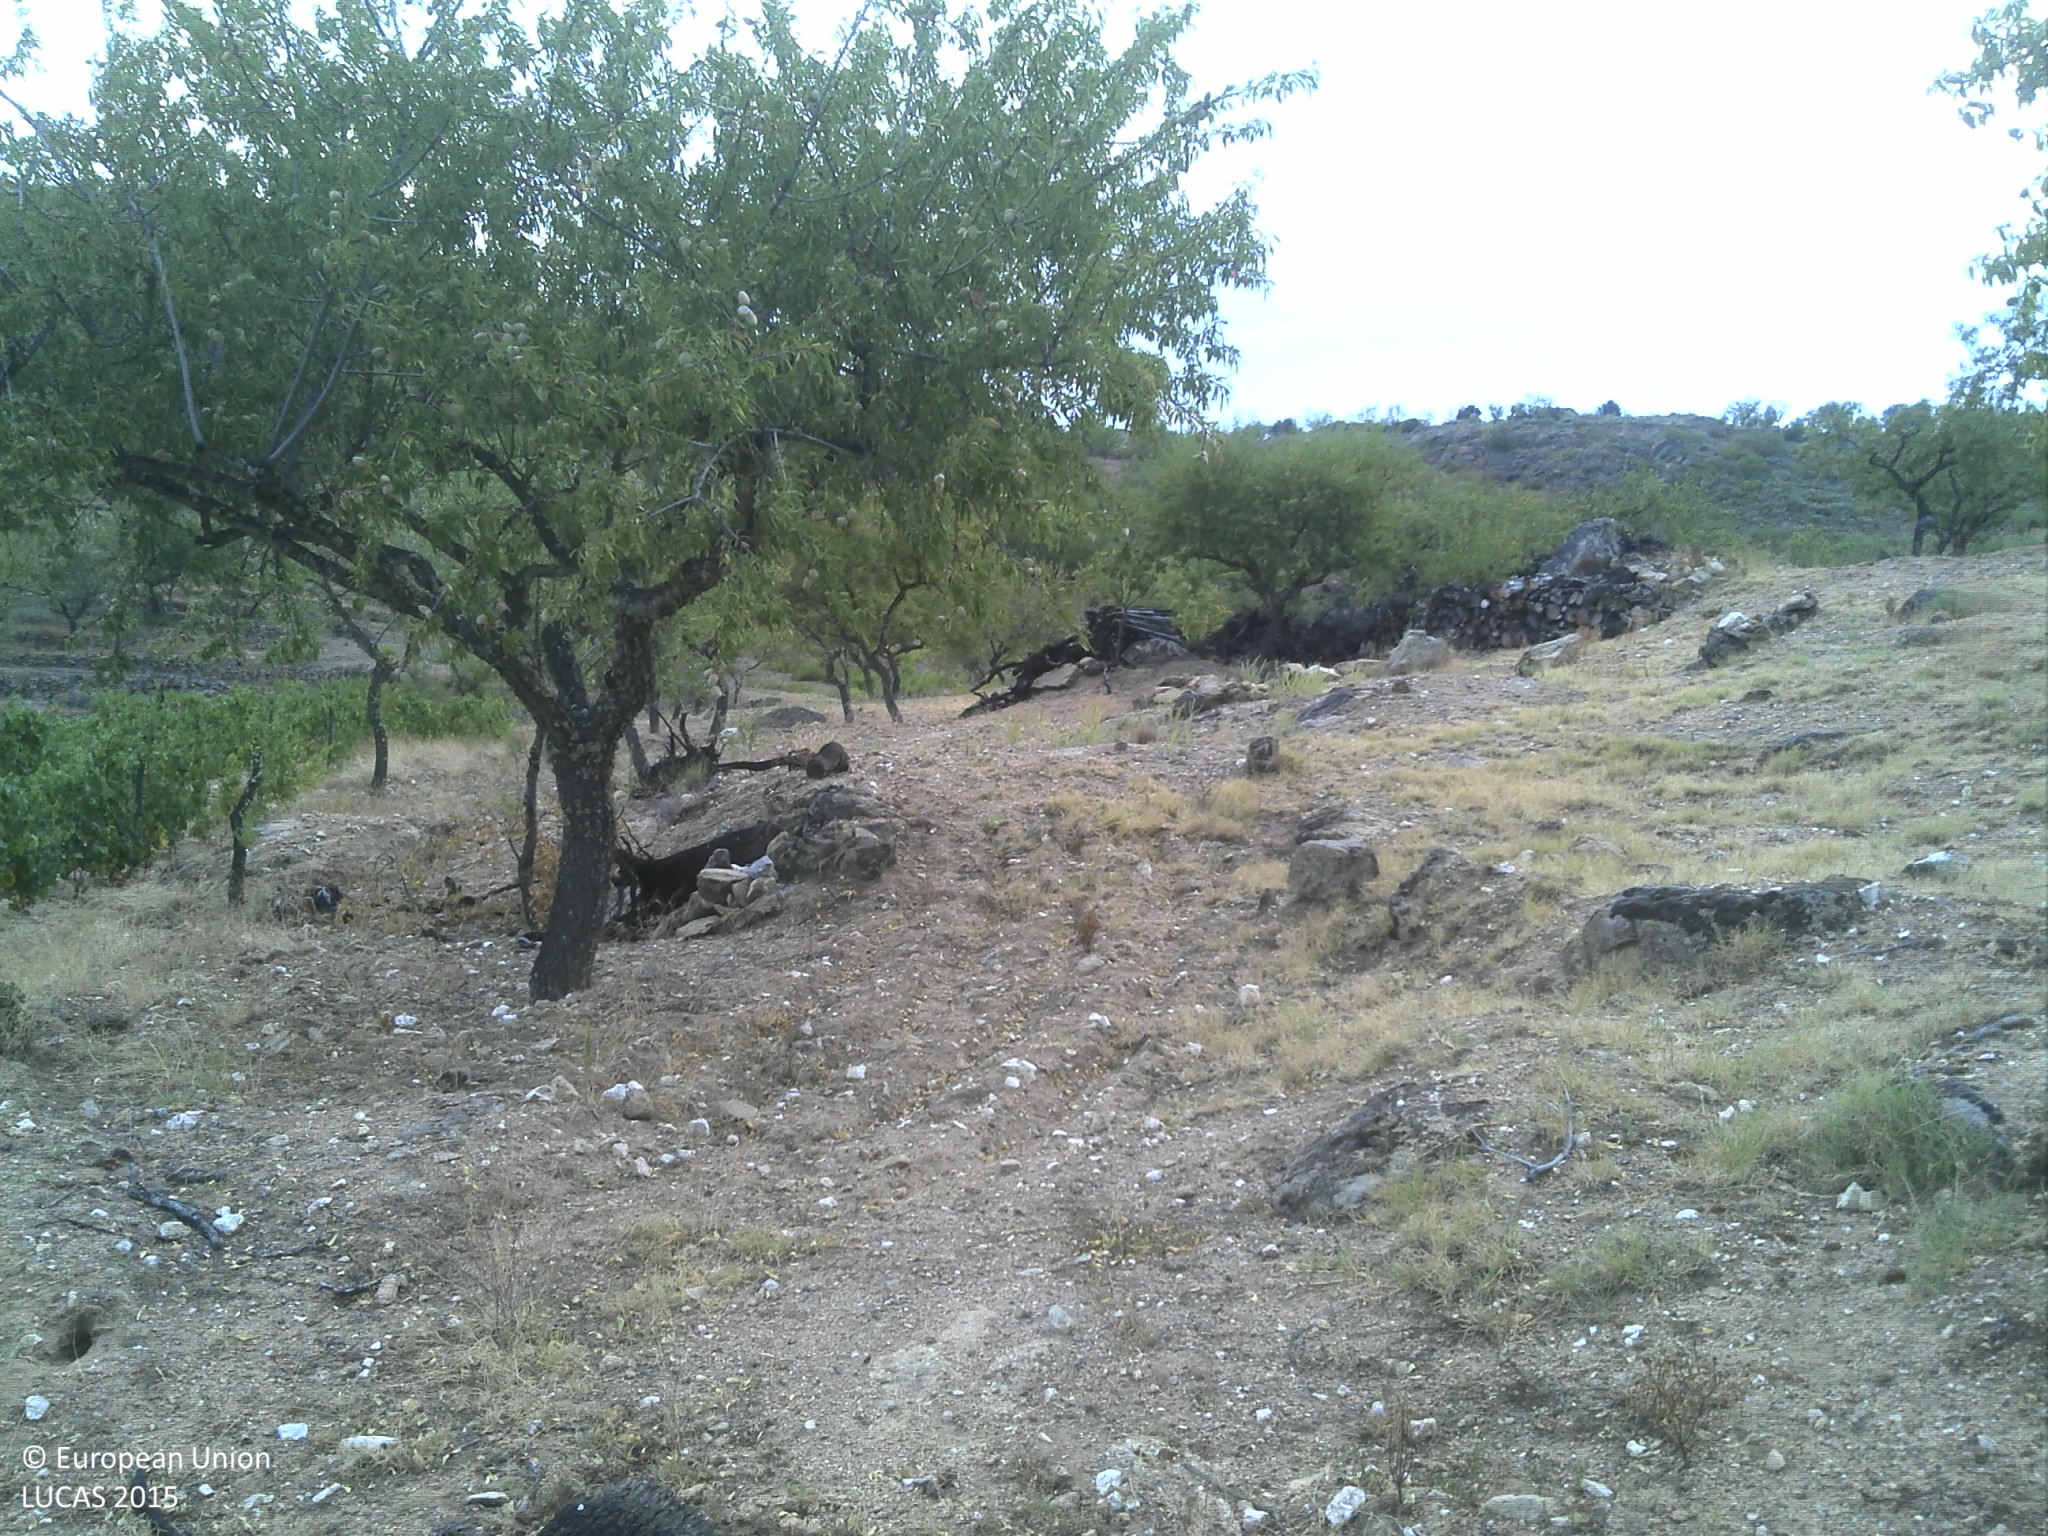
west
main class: Cropland
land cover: Nuts trees
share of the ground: 10 - 25 %
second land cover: Grassland without tree/shrub cover
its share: > 75 %
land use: Agriculture (excluding fallow land and kitchen gardens)
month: July
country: PT
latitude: 41.0880
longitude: -7.2446
